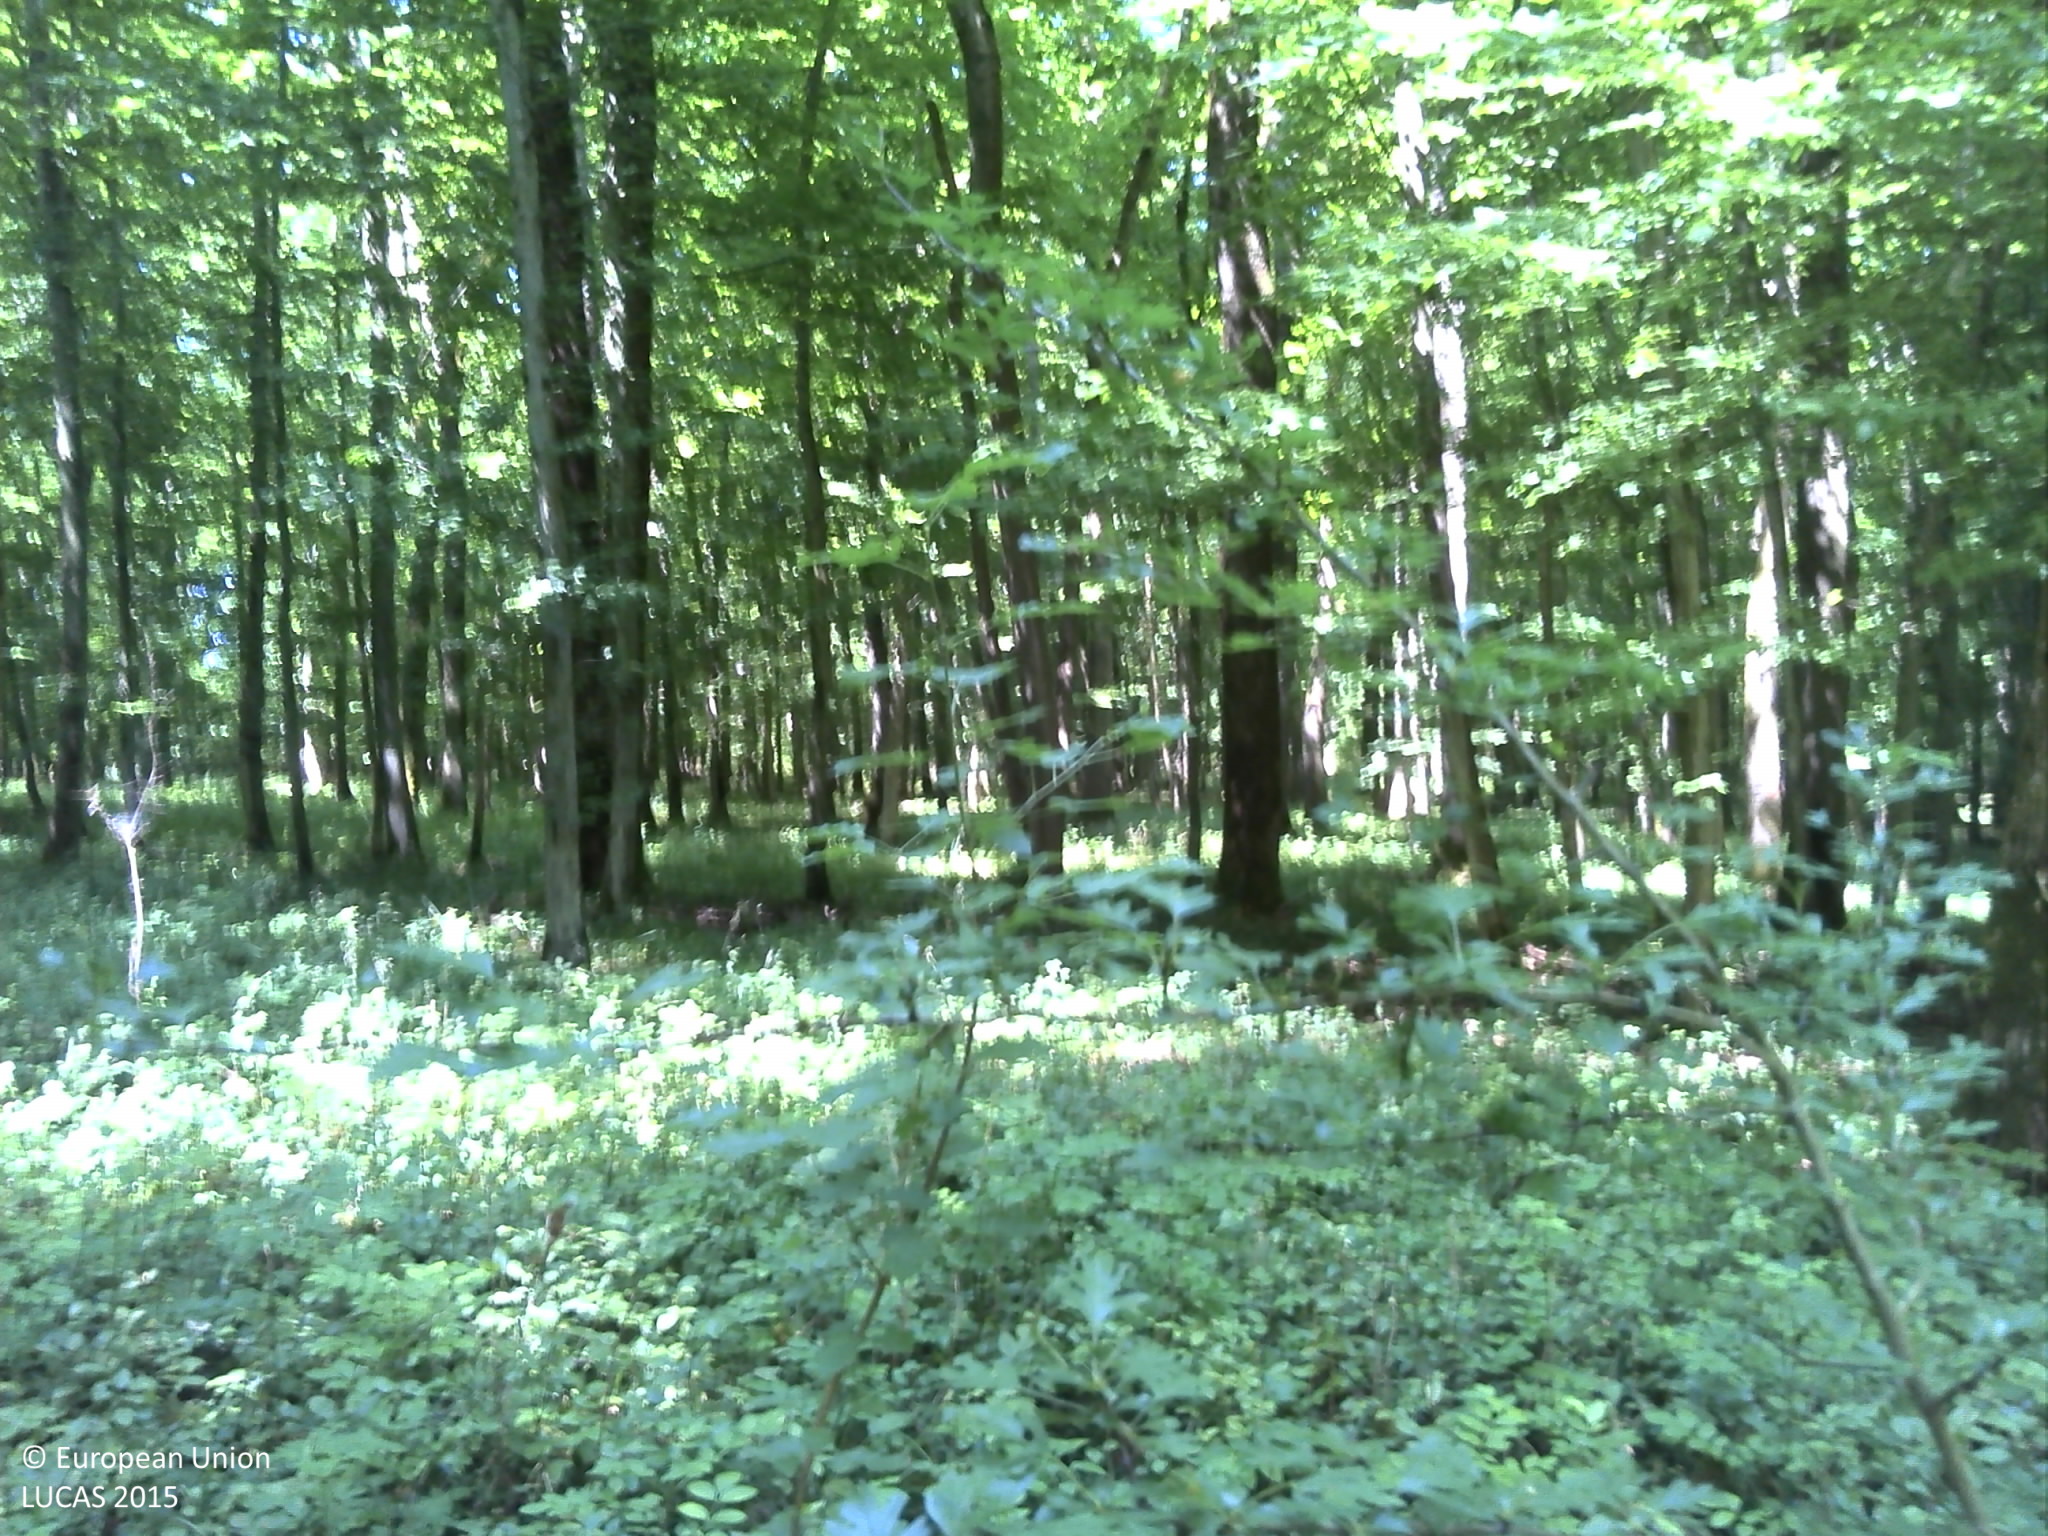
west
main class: Woodland
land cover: Broadleaved woodland
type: mesophytic deciduous forest
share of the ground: > 75 %
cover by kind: broadleaved forest trees 95 %, herbaceous plants 5 %
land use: Forestry
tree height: > 5 m
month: June
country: FR
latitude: 49.3804
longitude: 6.1289
